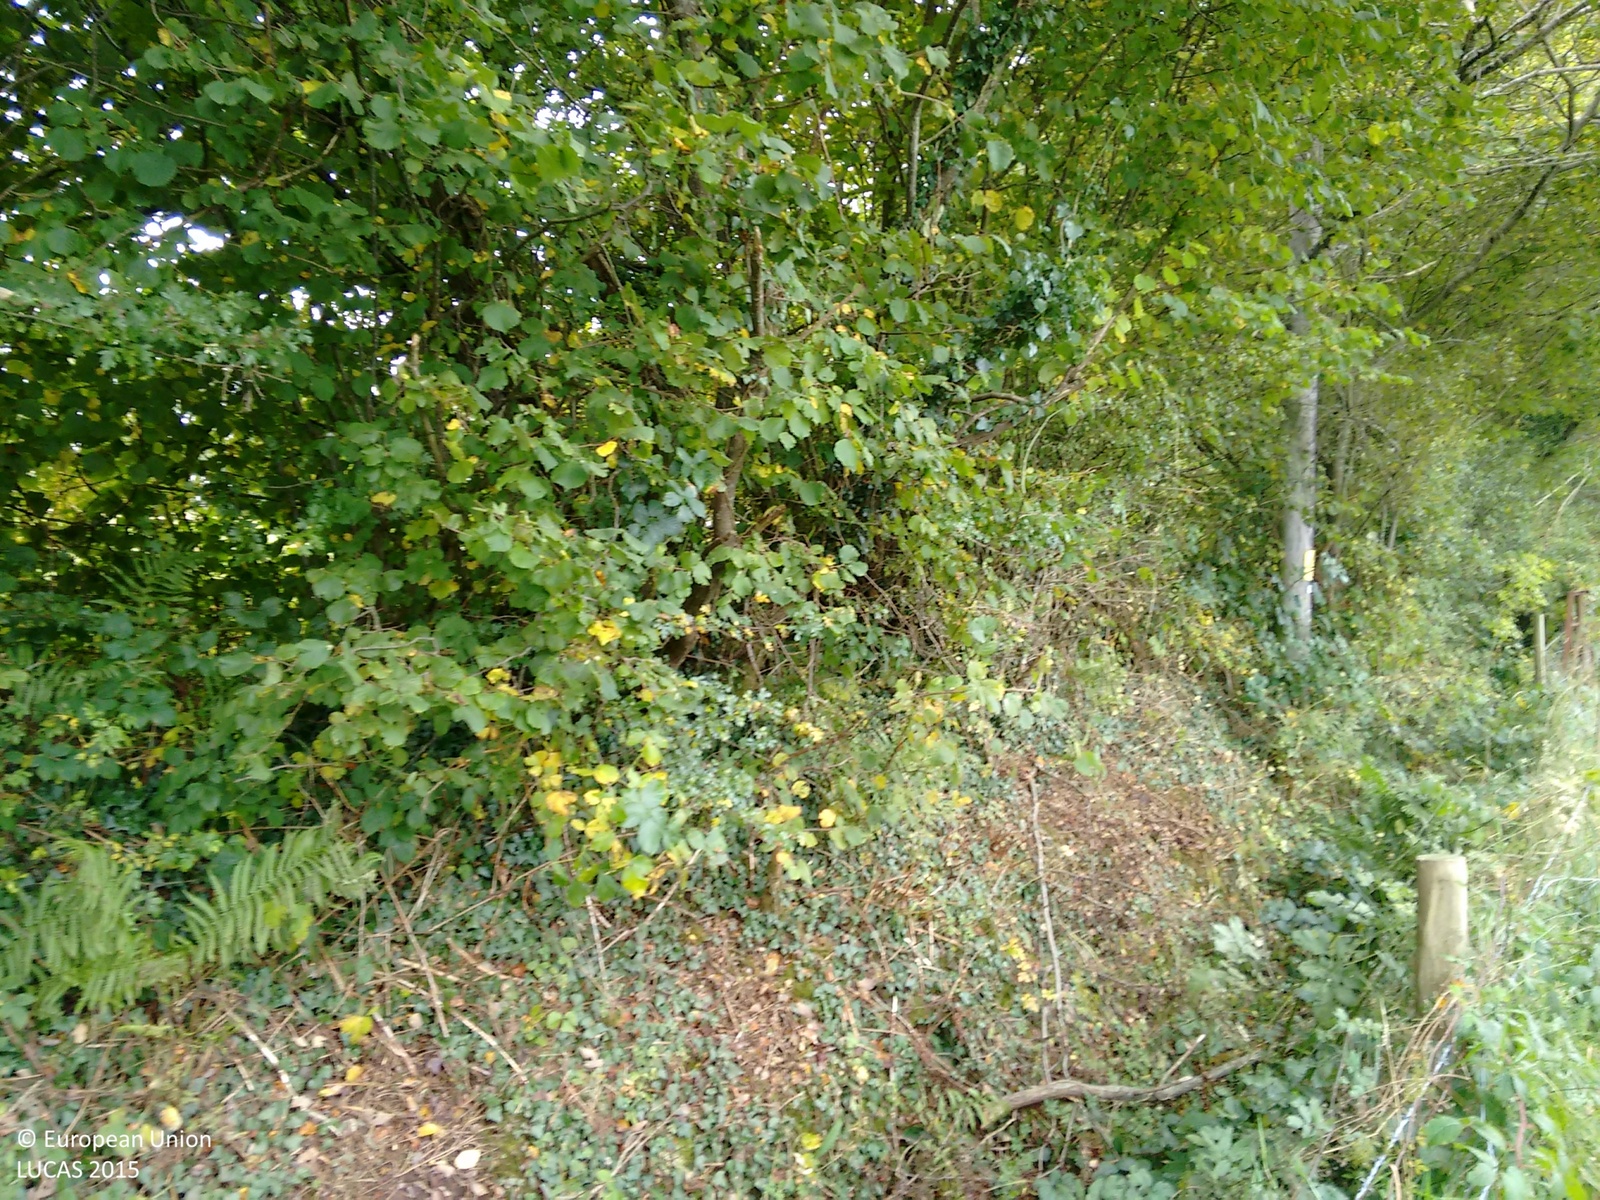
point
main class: Grassland
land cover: Grassland without tree/shrub cover
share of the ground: > 75 %
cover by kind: herbaceous plants 100 %
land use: Agriculture (excluding fallow land and kitchen gardens)
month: October
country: GB
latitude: 52.2372
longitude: -3.9911
